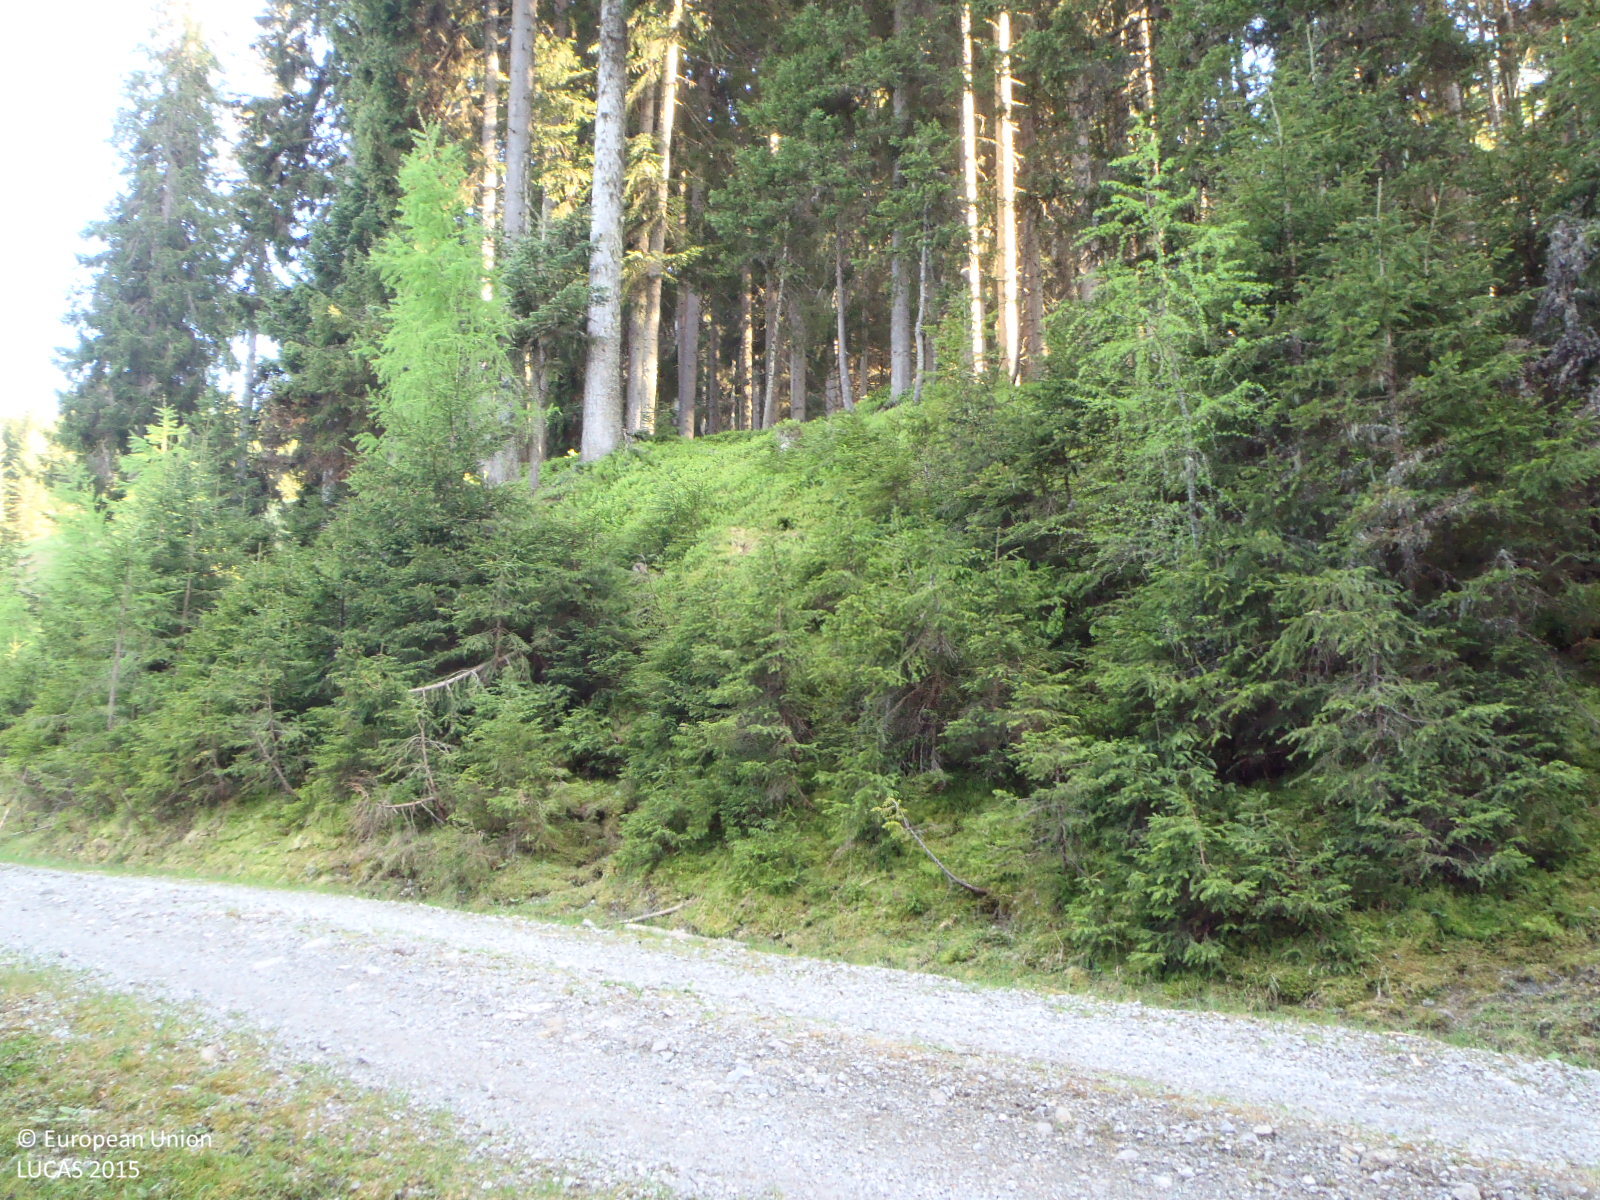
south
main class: Woodland
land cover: Spruce dominated coniferous woodland
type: alpine coniferous forest
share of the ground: > 75 %
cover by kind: coniferous forest trees 75 %, shrubs 20 %, herbaceous plants 5 %
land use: Forestry
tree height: > 5 m
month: May
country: AT
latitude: 47.3588
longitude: 13.4538
